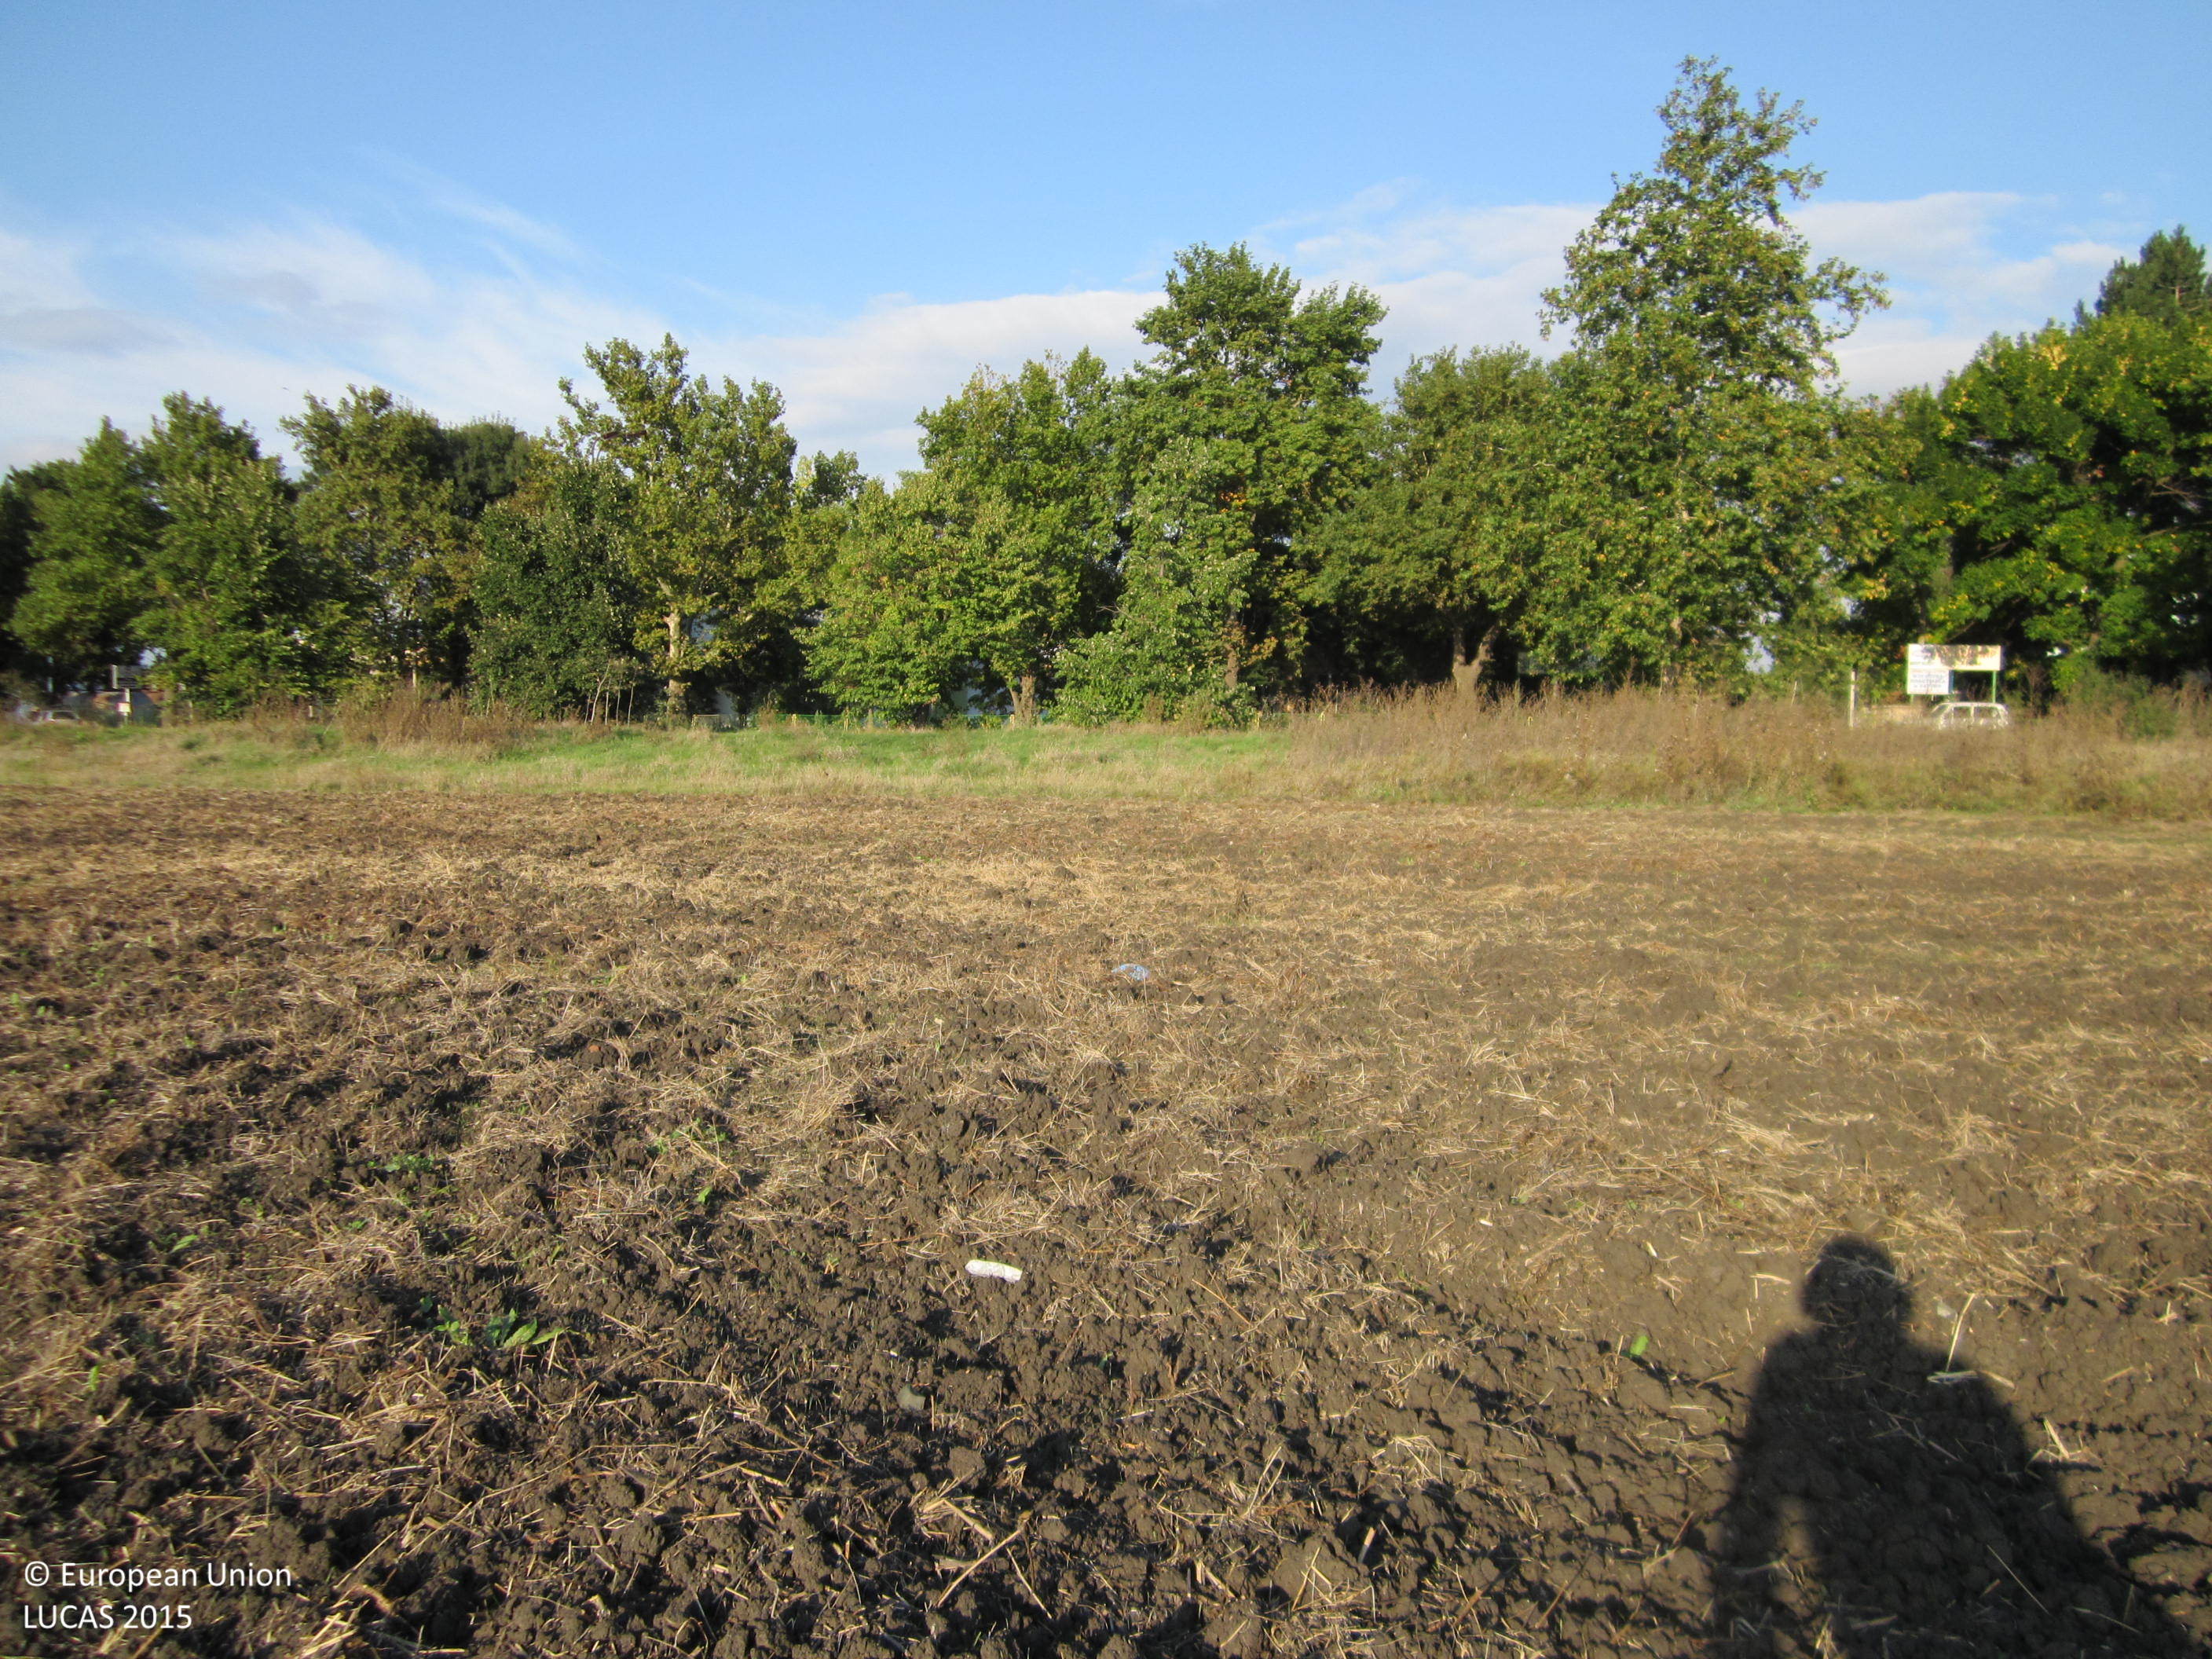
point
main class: Cropland
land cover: Common wheat
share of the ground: < 10 %
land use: Agriculture (excluding fallow land and kitchen gardens)
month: October
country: BG
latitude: 42.6627
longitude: 26.9791
